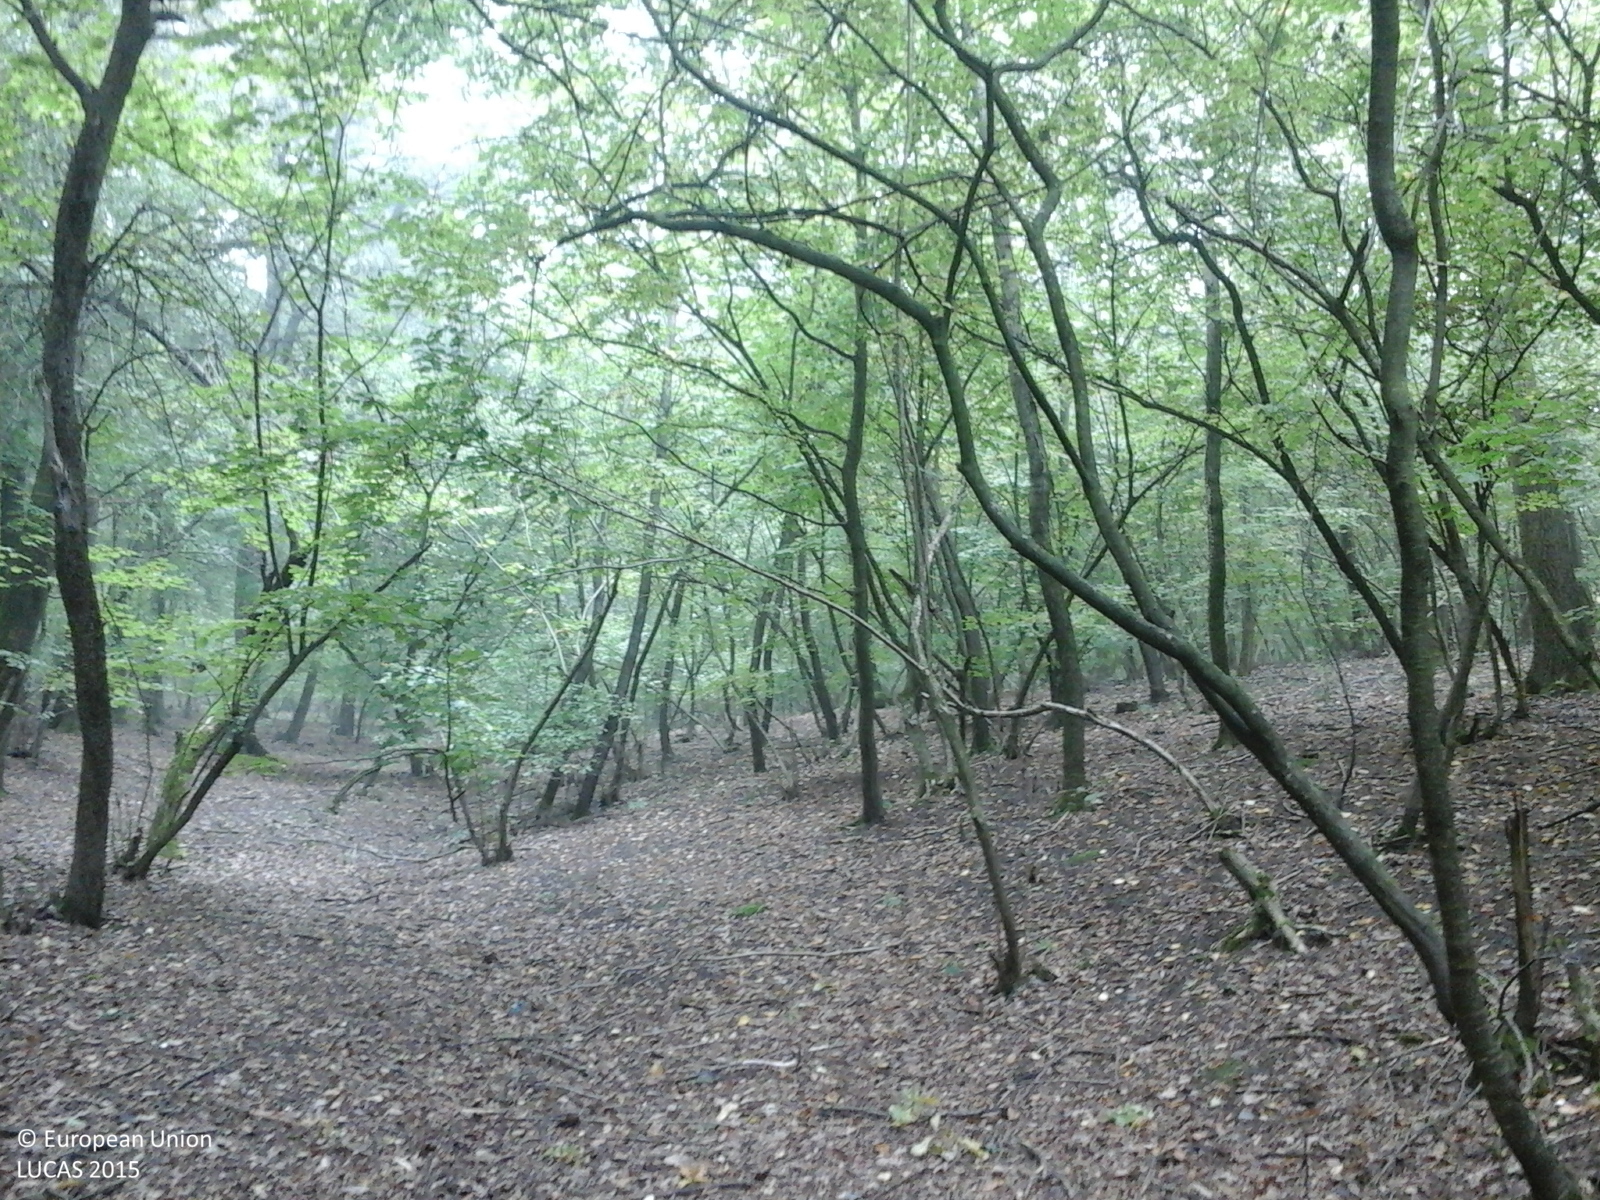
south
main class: Woodland
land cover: Broadleaved woodland
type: mesophytic deciduous forest
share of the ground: > 75 %
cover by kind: broadleaved forest trees 100 %
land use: Forestry
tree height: > 5 m
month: October
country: RO
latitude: 46.3409
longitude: 24.2555
